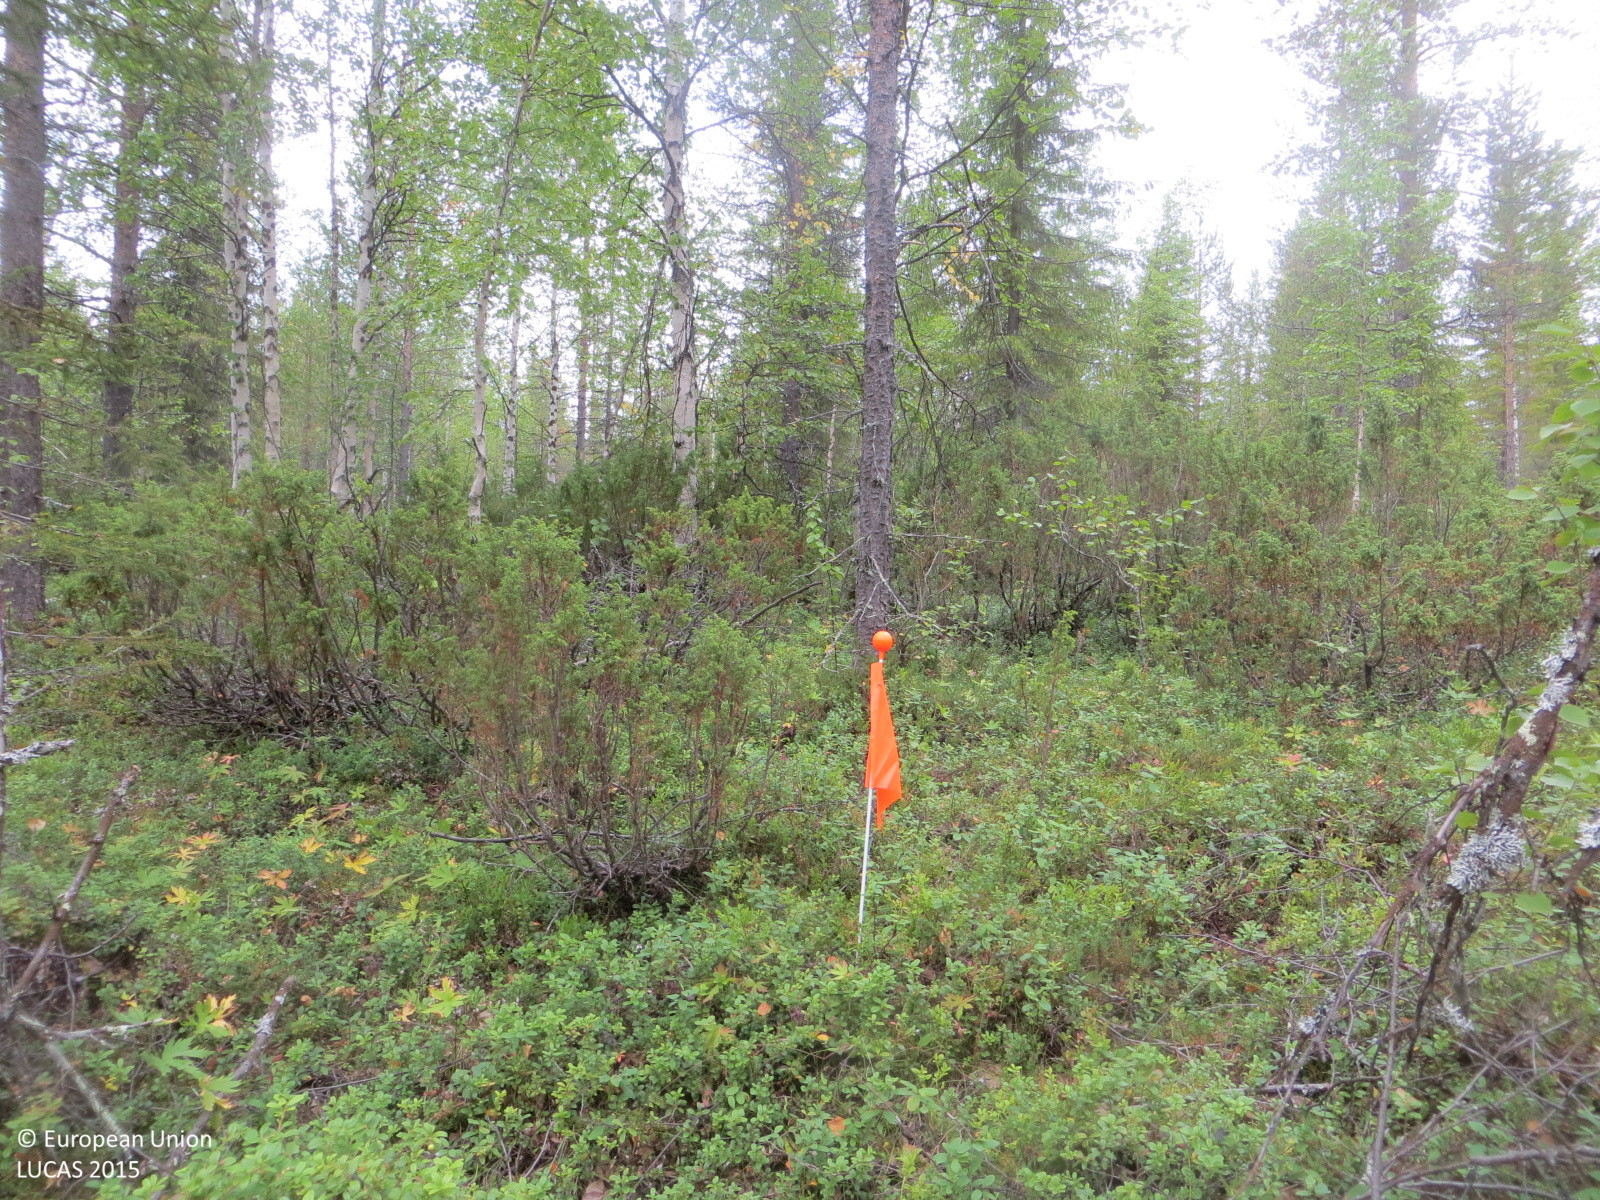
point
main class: Woodland
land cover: Pine dominated mixed woodland
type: boreal forest
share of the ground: 50 - 75 %
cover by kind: broadleaved forest trees 40 %, shrubs 40 %, coniferous forest trees 20 %
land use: Forestry
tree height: > 5 m
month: August
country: FI
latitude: 67.9943
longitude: 25.1732
